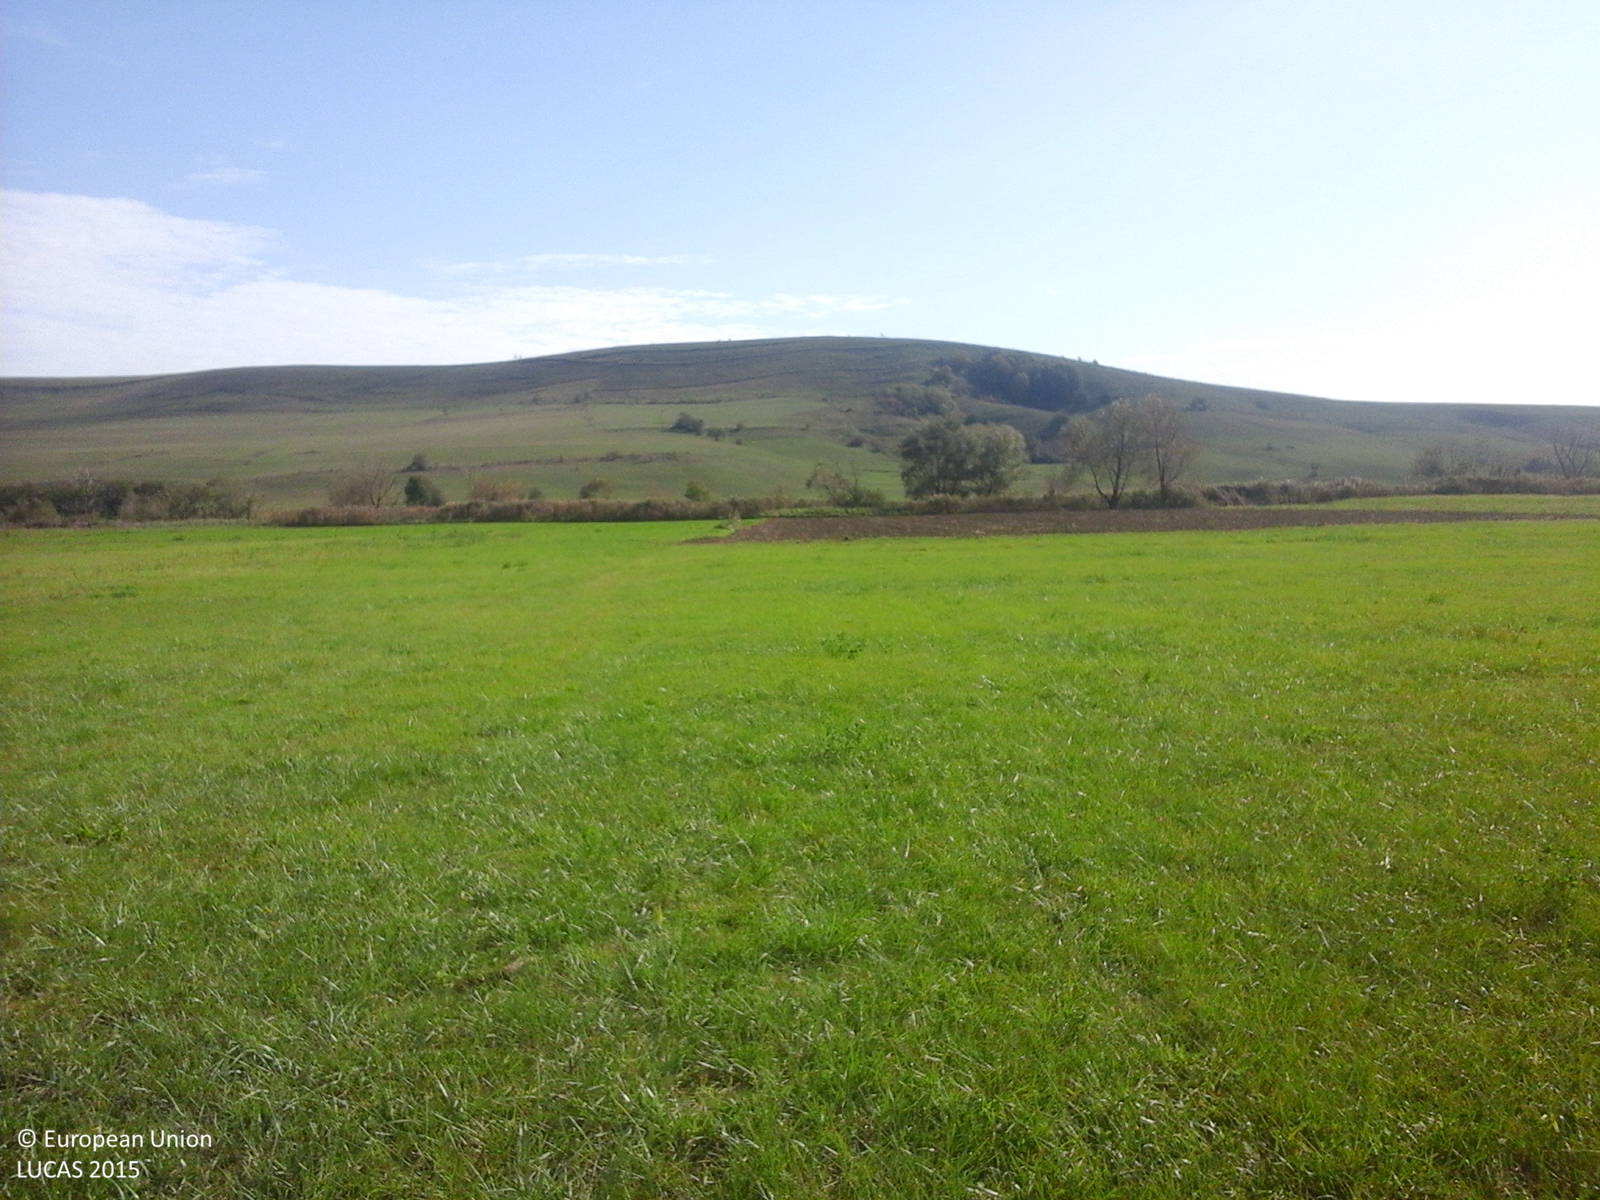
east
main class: Grassland
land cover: Grassland without tree/shrub cover
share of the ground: > 75 %
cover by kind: herbaceous plants 100 %
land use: Agriculture (excluding fallow land and kitchen gardens)
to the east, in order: Grassland without tree/shrub cover; Tracks; Lucerne; Grassland without tree/shrub cover; Abandoned hedges; Ditches and canals
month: October
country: RO
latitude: 46.2011
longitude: 25.3830
